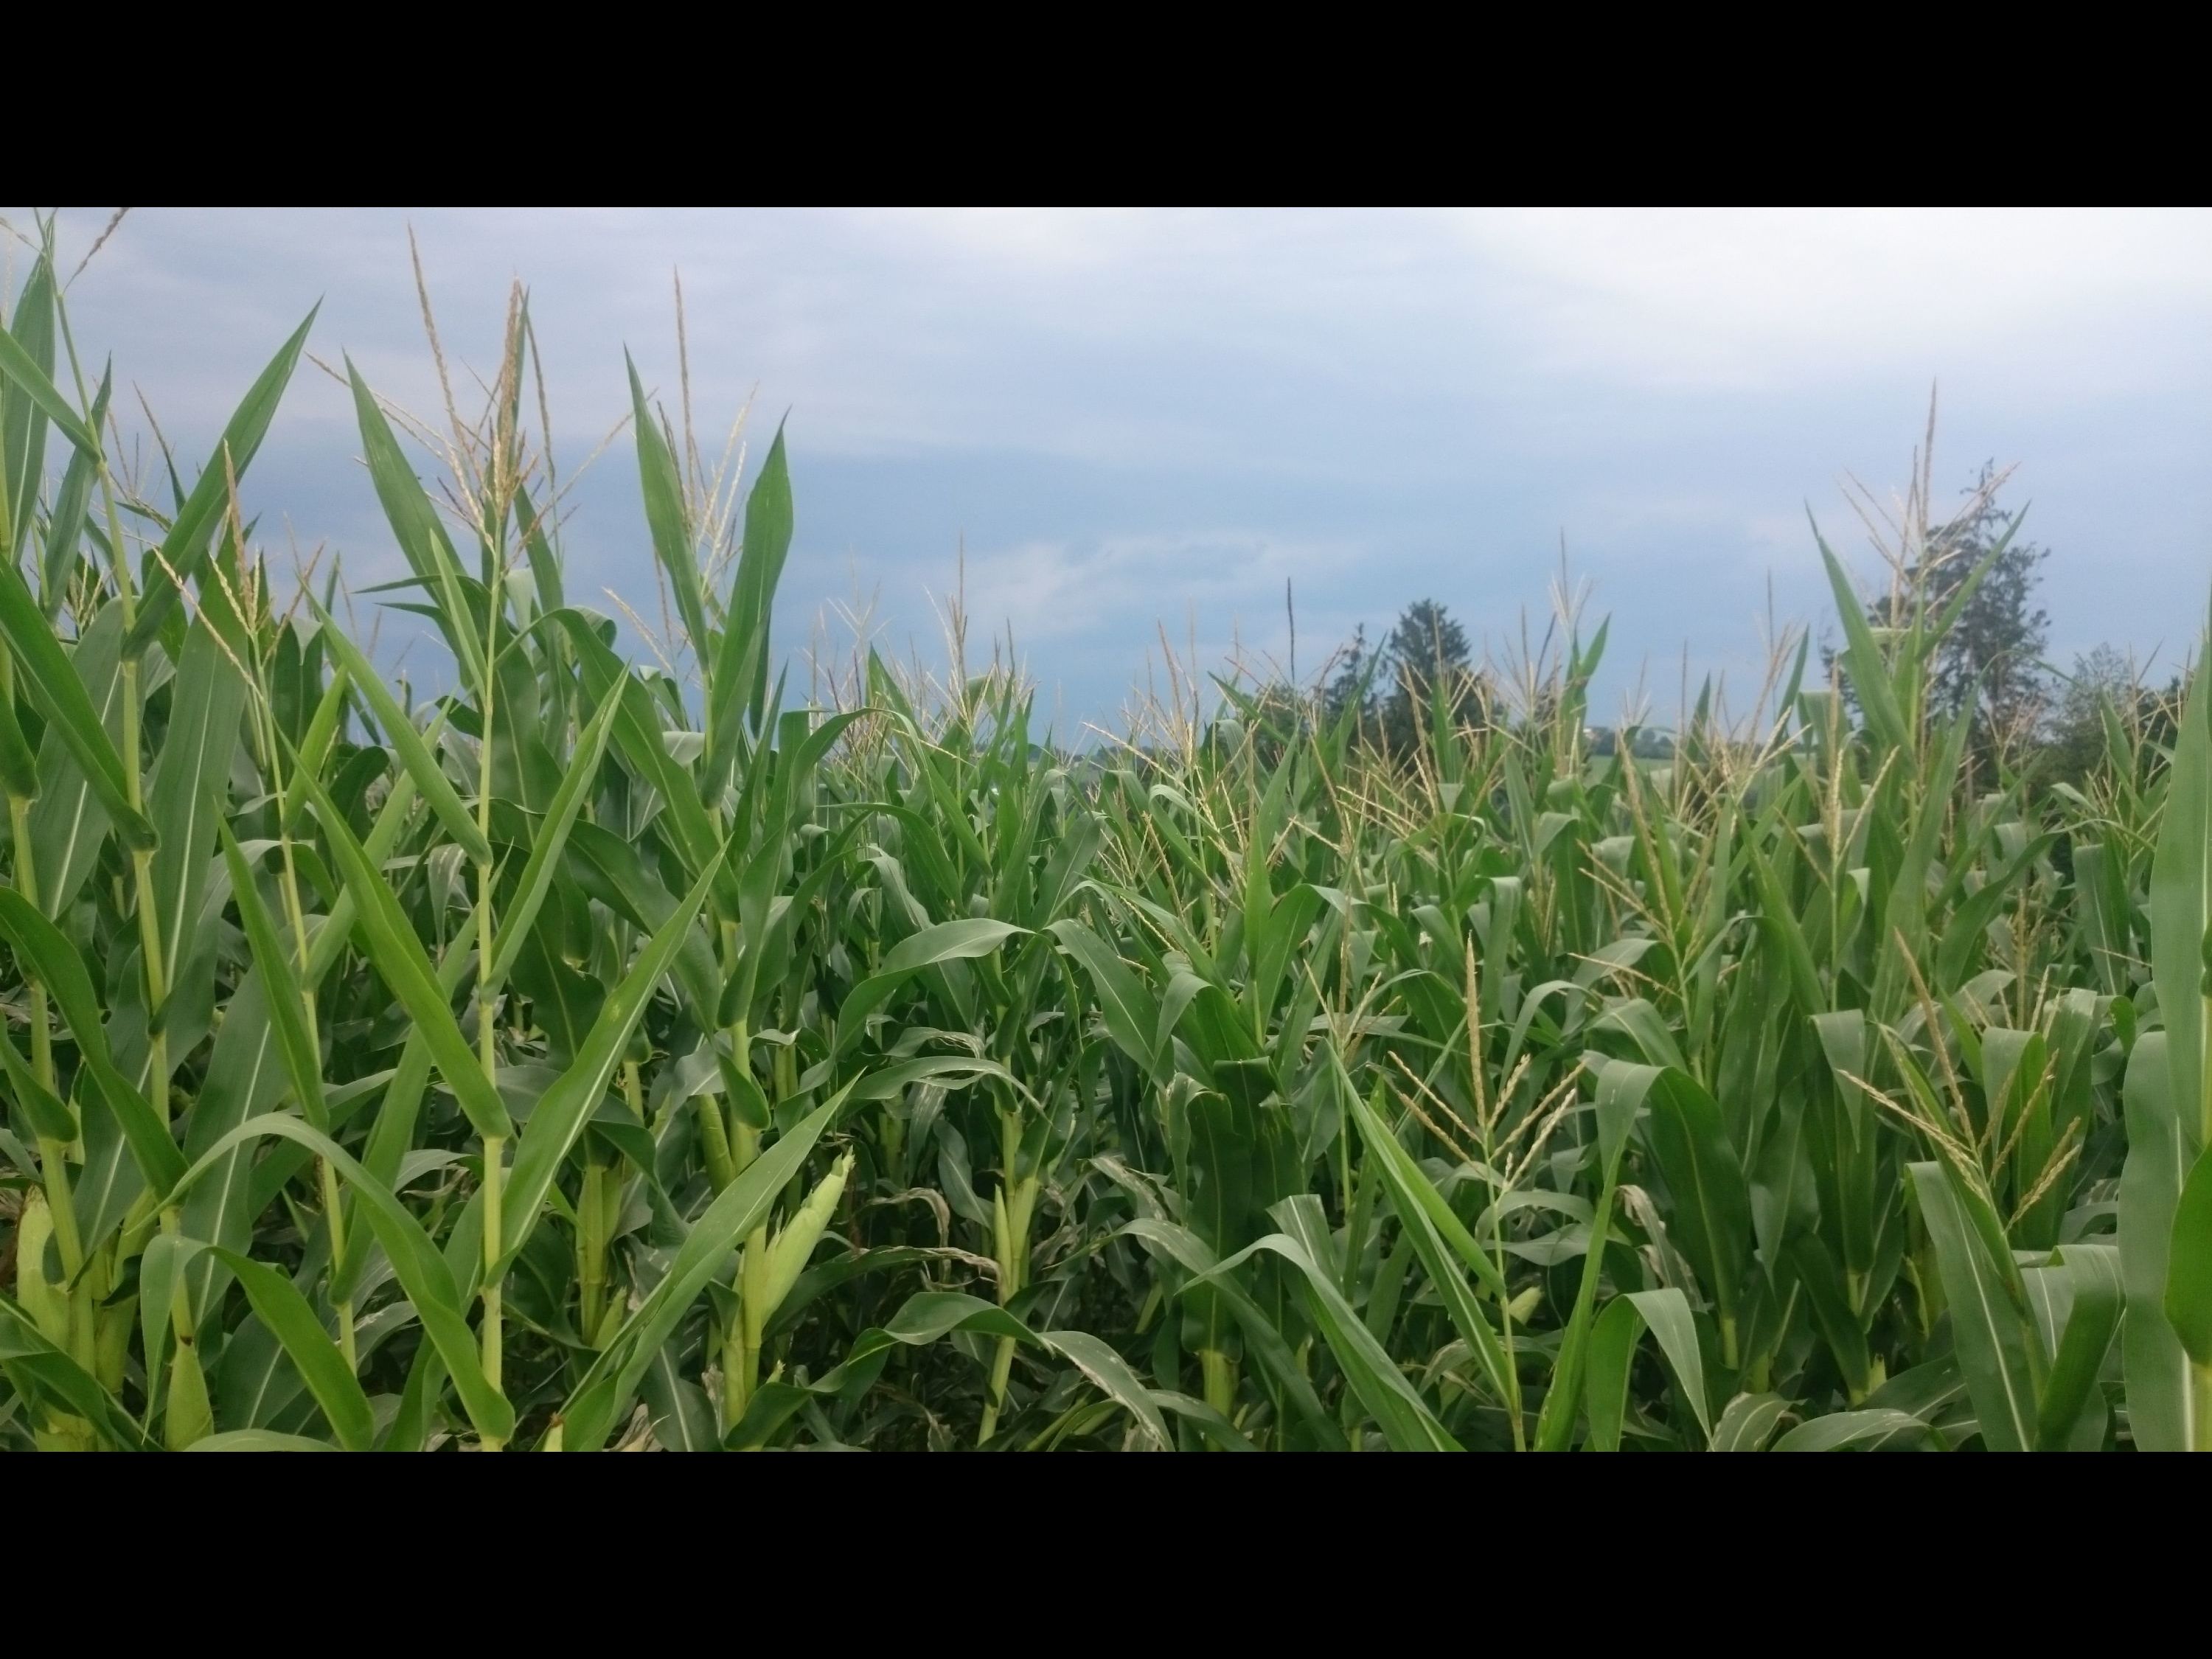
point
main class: Cropland
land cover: Maize
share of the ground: > 75 %
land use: Agriculture (excluding fallow land and kitchen gardens)
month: July
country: AT
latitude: 46.9646
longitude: 15.9016
